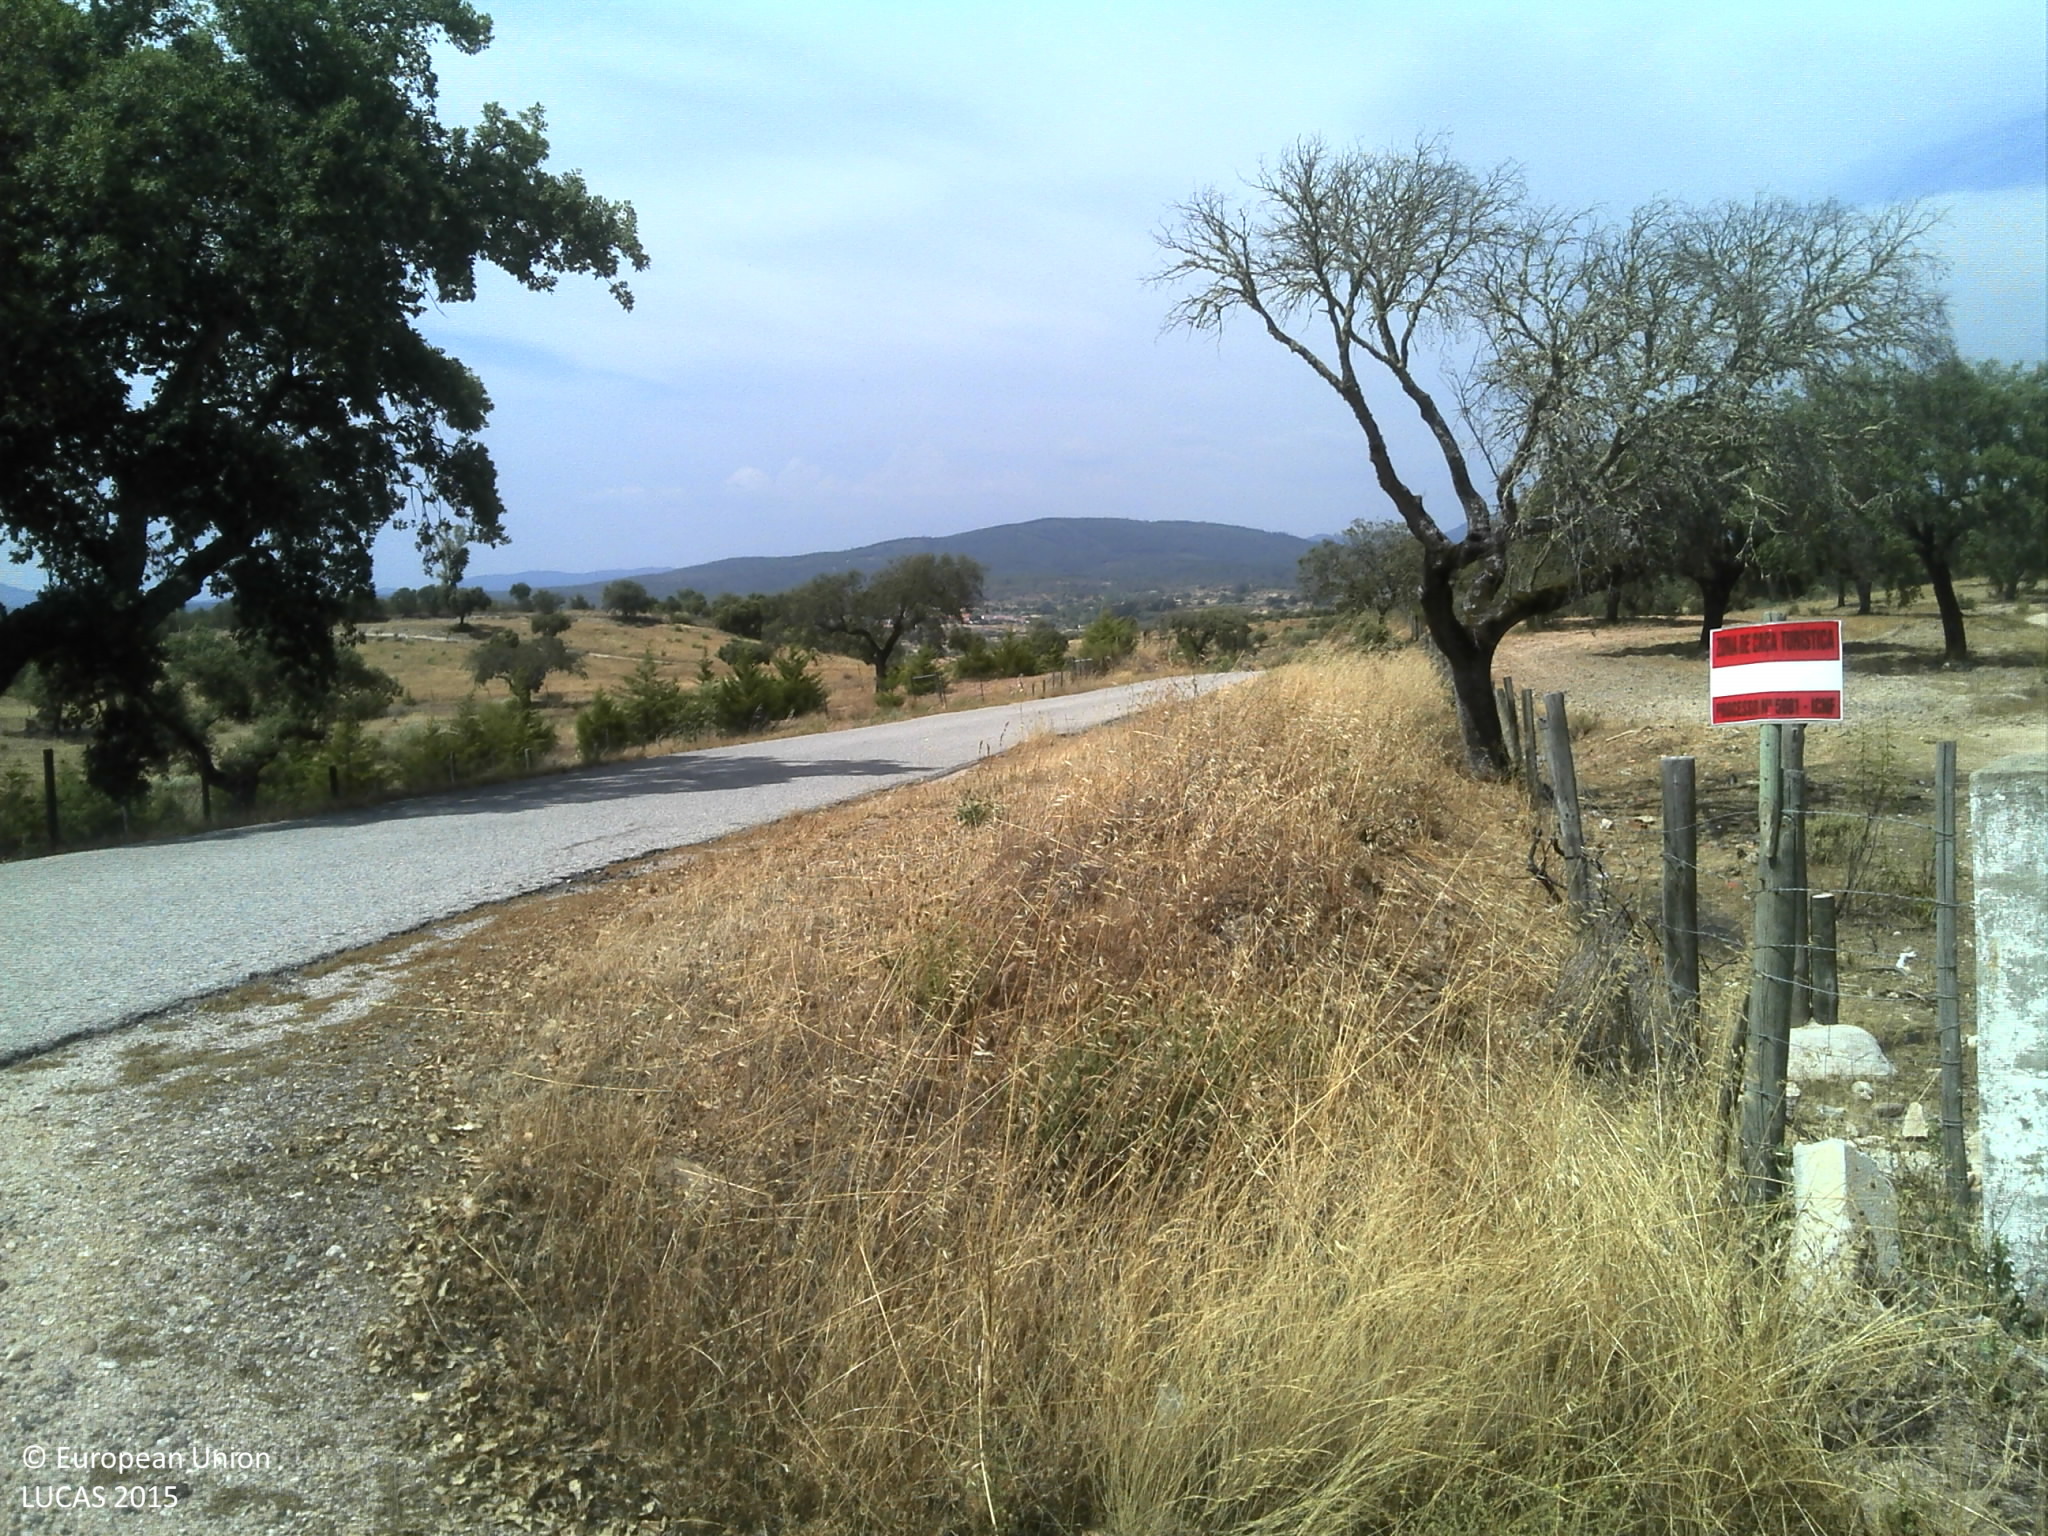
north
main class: Woodland
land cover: Broadleaved woodland
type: broadleaved evergreen forest
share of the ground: 25 - 50 %
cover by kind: broadleaved forest trees 40 %, herbaceous plants 40 %, unconsolidated bare surface 20 %
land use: Forestry
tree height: > 5 m
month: June
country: PT
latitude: 39.8941
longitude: -7.0119
